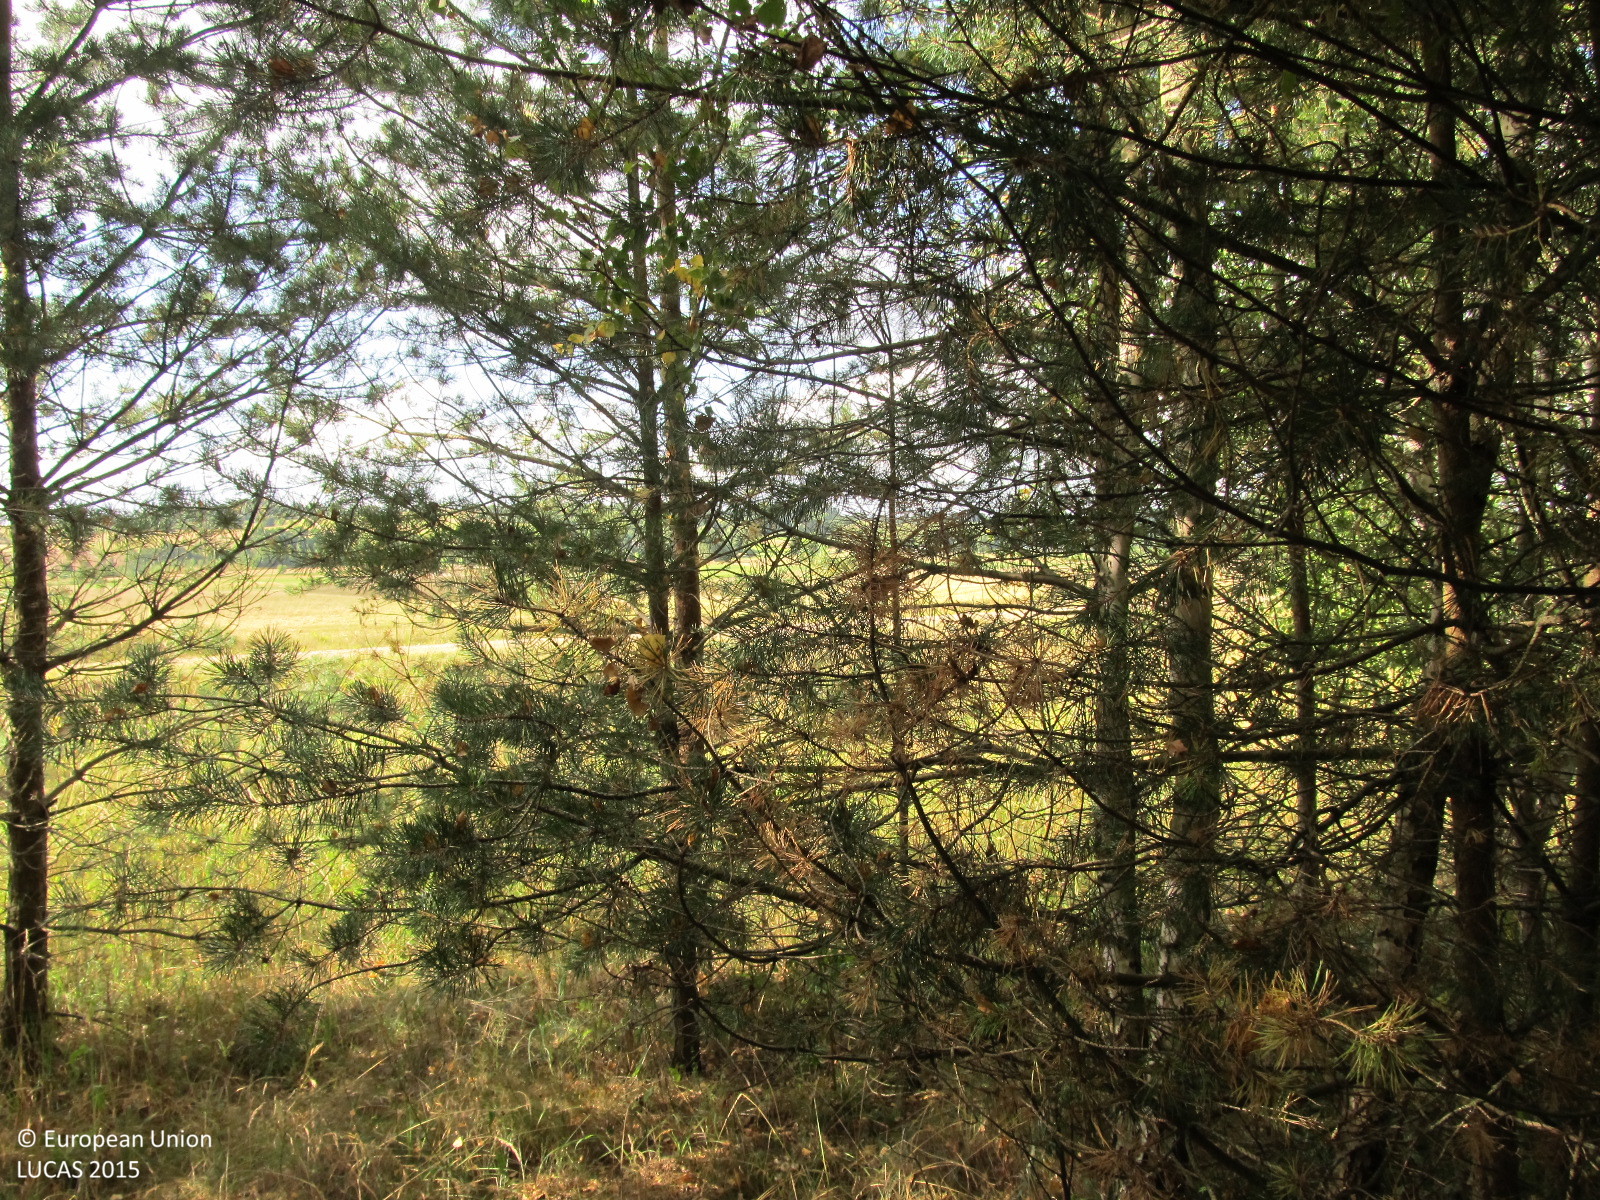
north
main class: Woodland
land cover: Pine dominated coniferous woodland
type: hemiboreal forest and nemoral coniferous forest and mixed broadleaved-coniferous forest
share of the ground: 50 - 75 %
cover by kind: coniferous forest trees 70 %, herbaceous plants 30 %
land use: Forestry
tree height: < 5 m
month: August
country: LT
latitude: 55.6756
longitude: 22.9323
